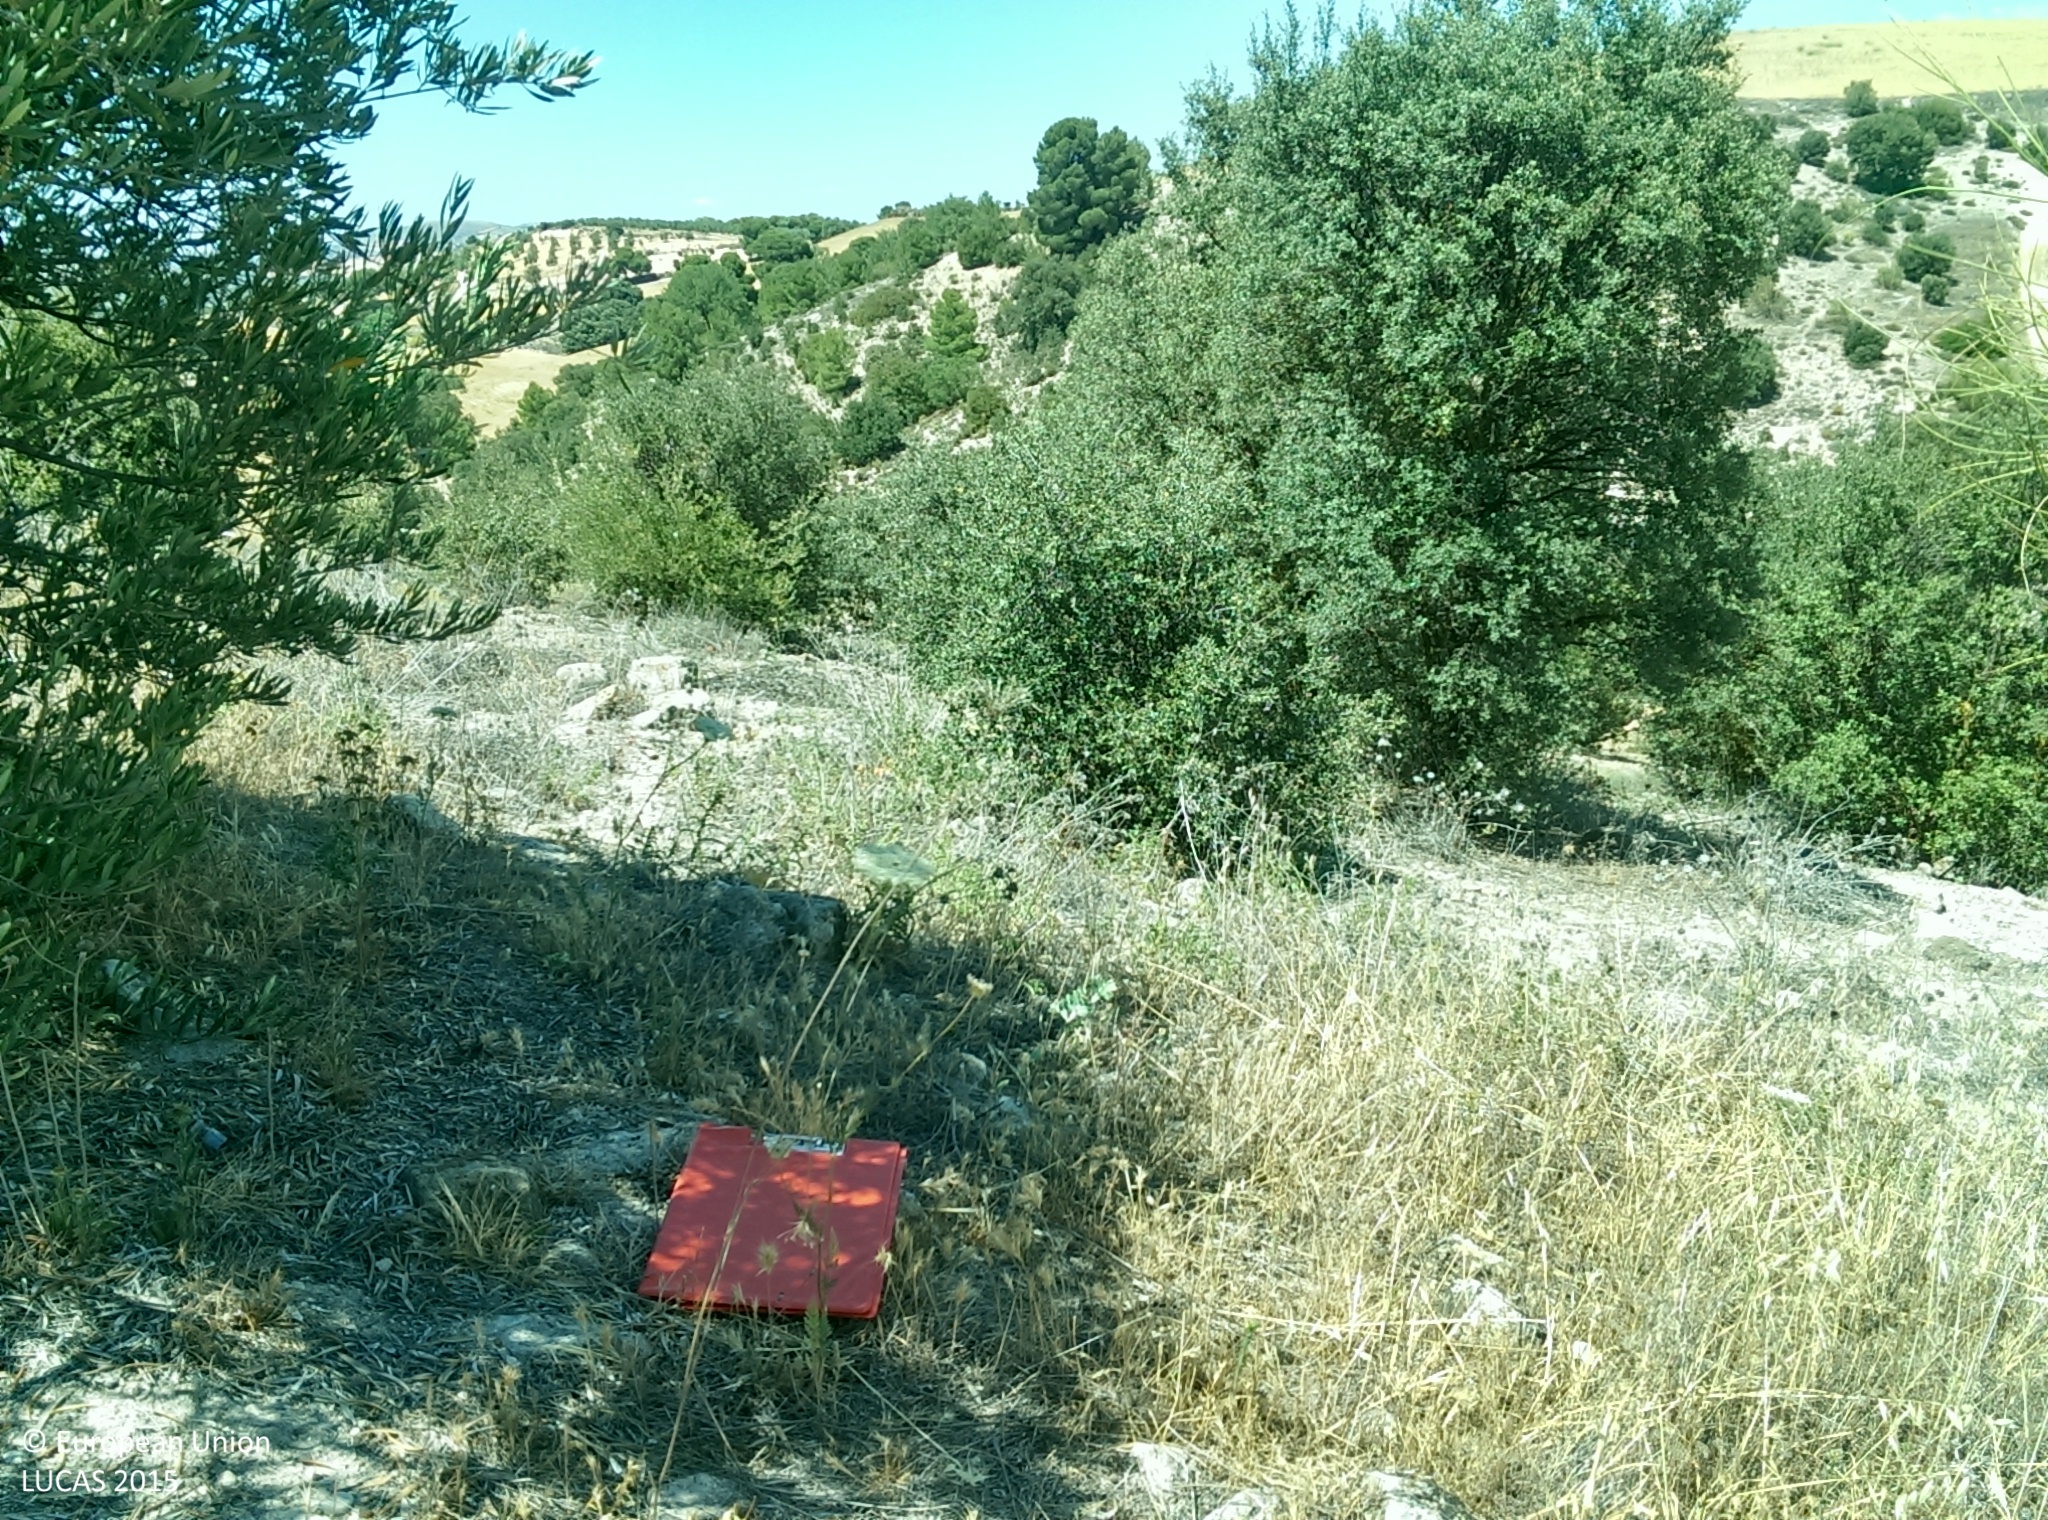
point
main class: Shrubland
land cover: Shrubland with sparse tree cover
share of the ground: 50 - 75 %
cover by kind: shrubs 50 %, herbaceous plants 40 %, broadleaved forest trees 5 %, unconsolidated bare surface 5 %
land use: Semi-natural and natural areas not in use
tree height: < 5 m
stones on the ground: 10 - 25 %
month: June
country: ES
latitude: 37.5588
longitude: -3.3168
